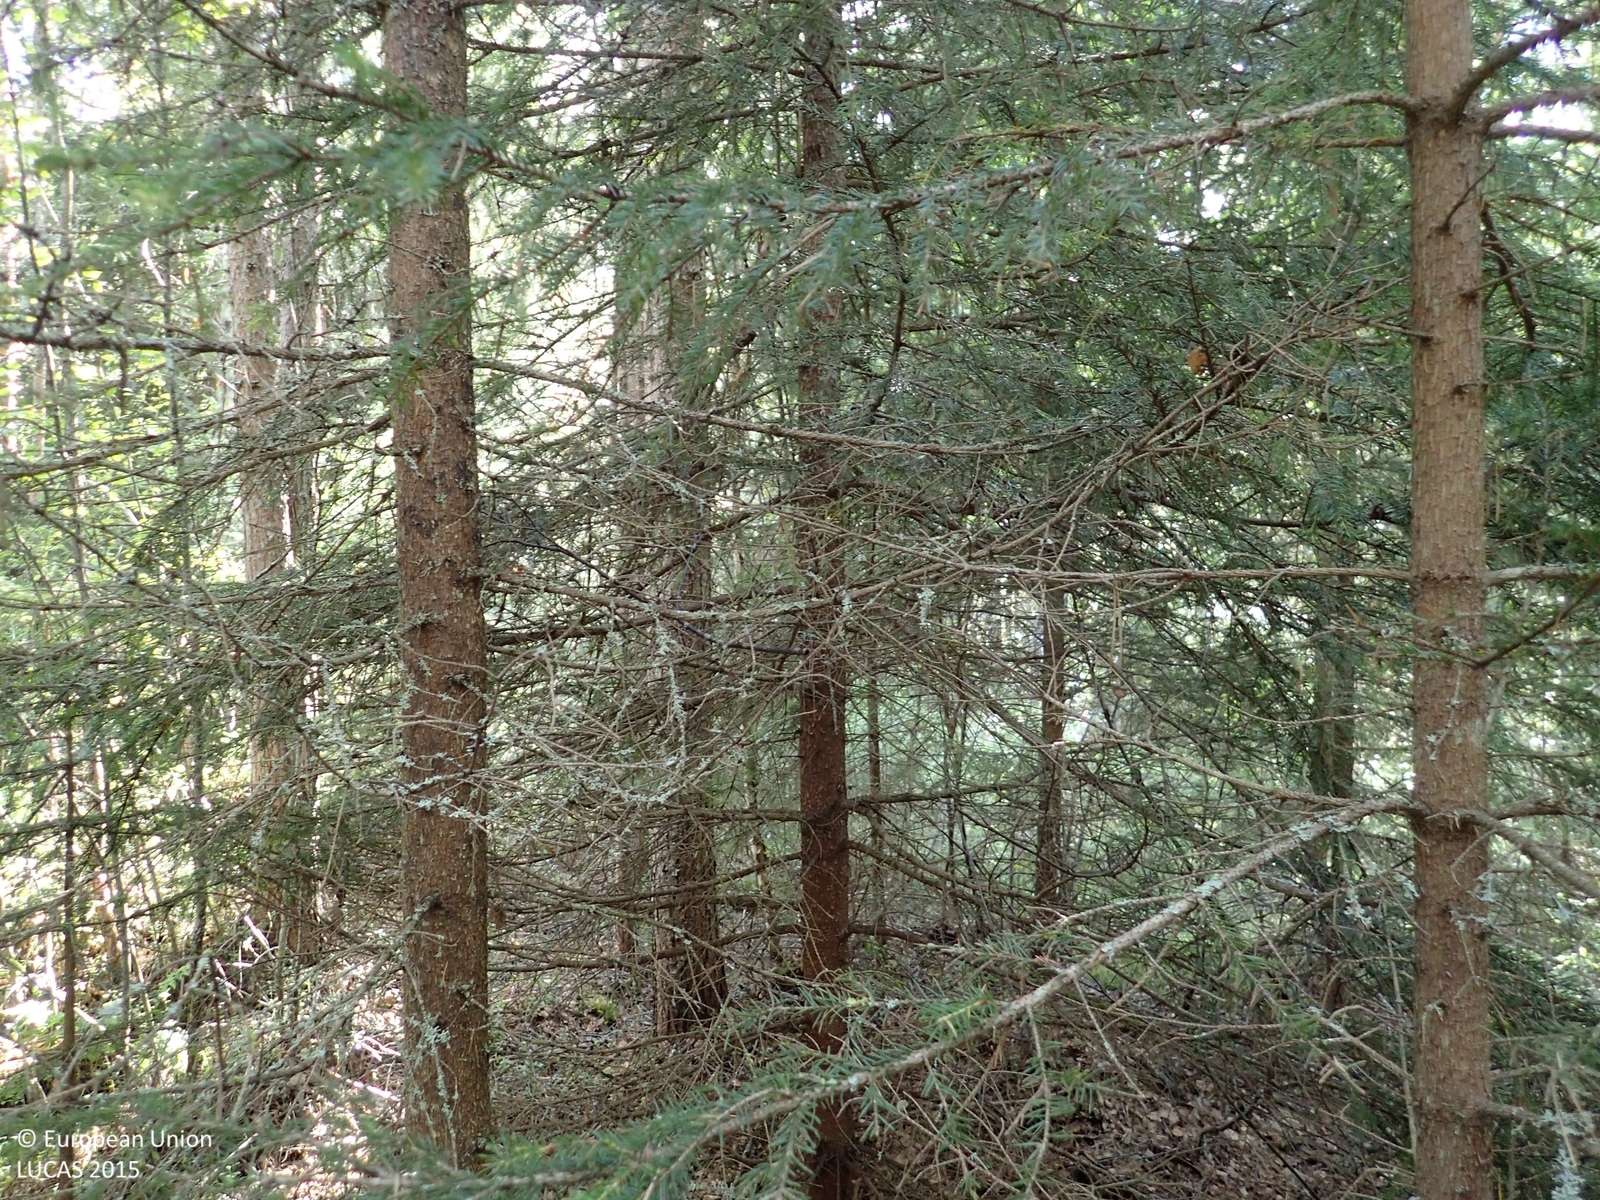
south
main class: Woodland
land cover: Other mixed woodland
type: boreal forest
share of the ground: > 75 %
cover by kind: coniferous forest trees 60 %, broadleaved forest trees 25 %, shrubs 10 %, lichens and mosses 5 %
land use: Forestry
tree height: > 5 m
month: August
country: FI
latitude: 62.2809
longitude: 23.0350
